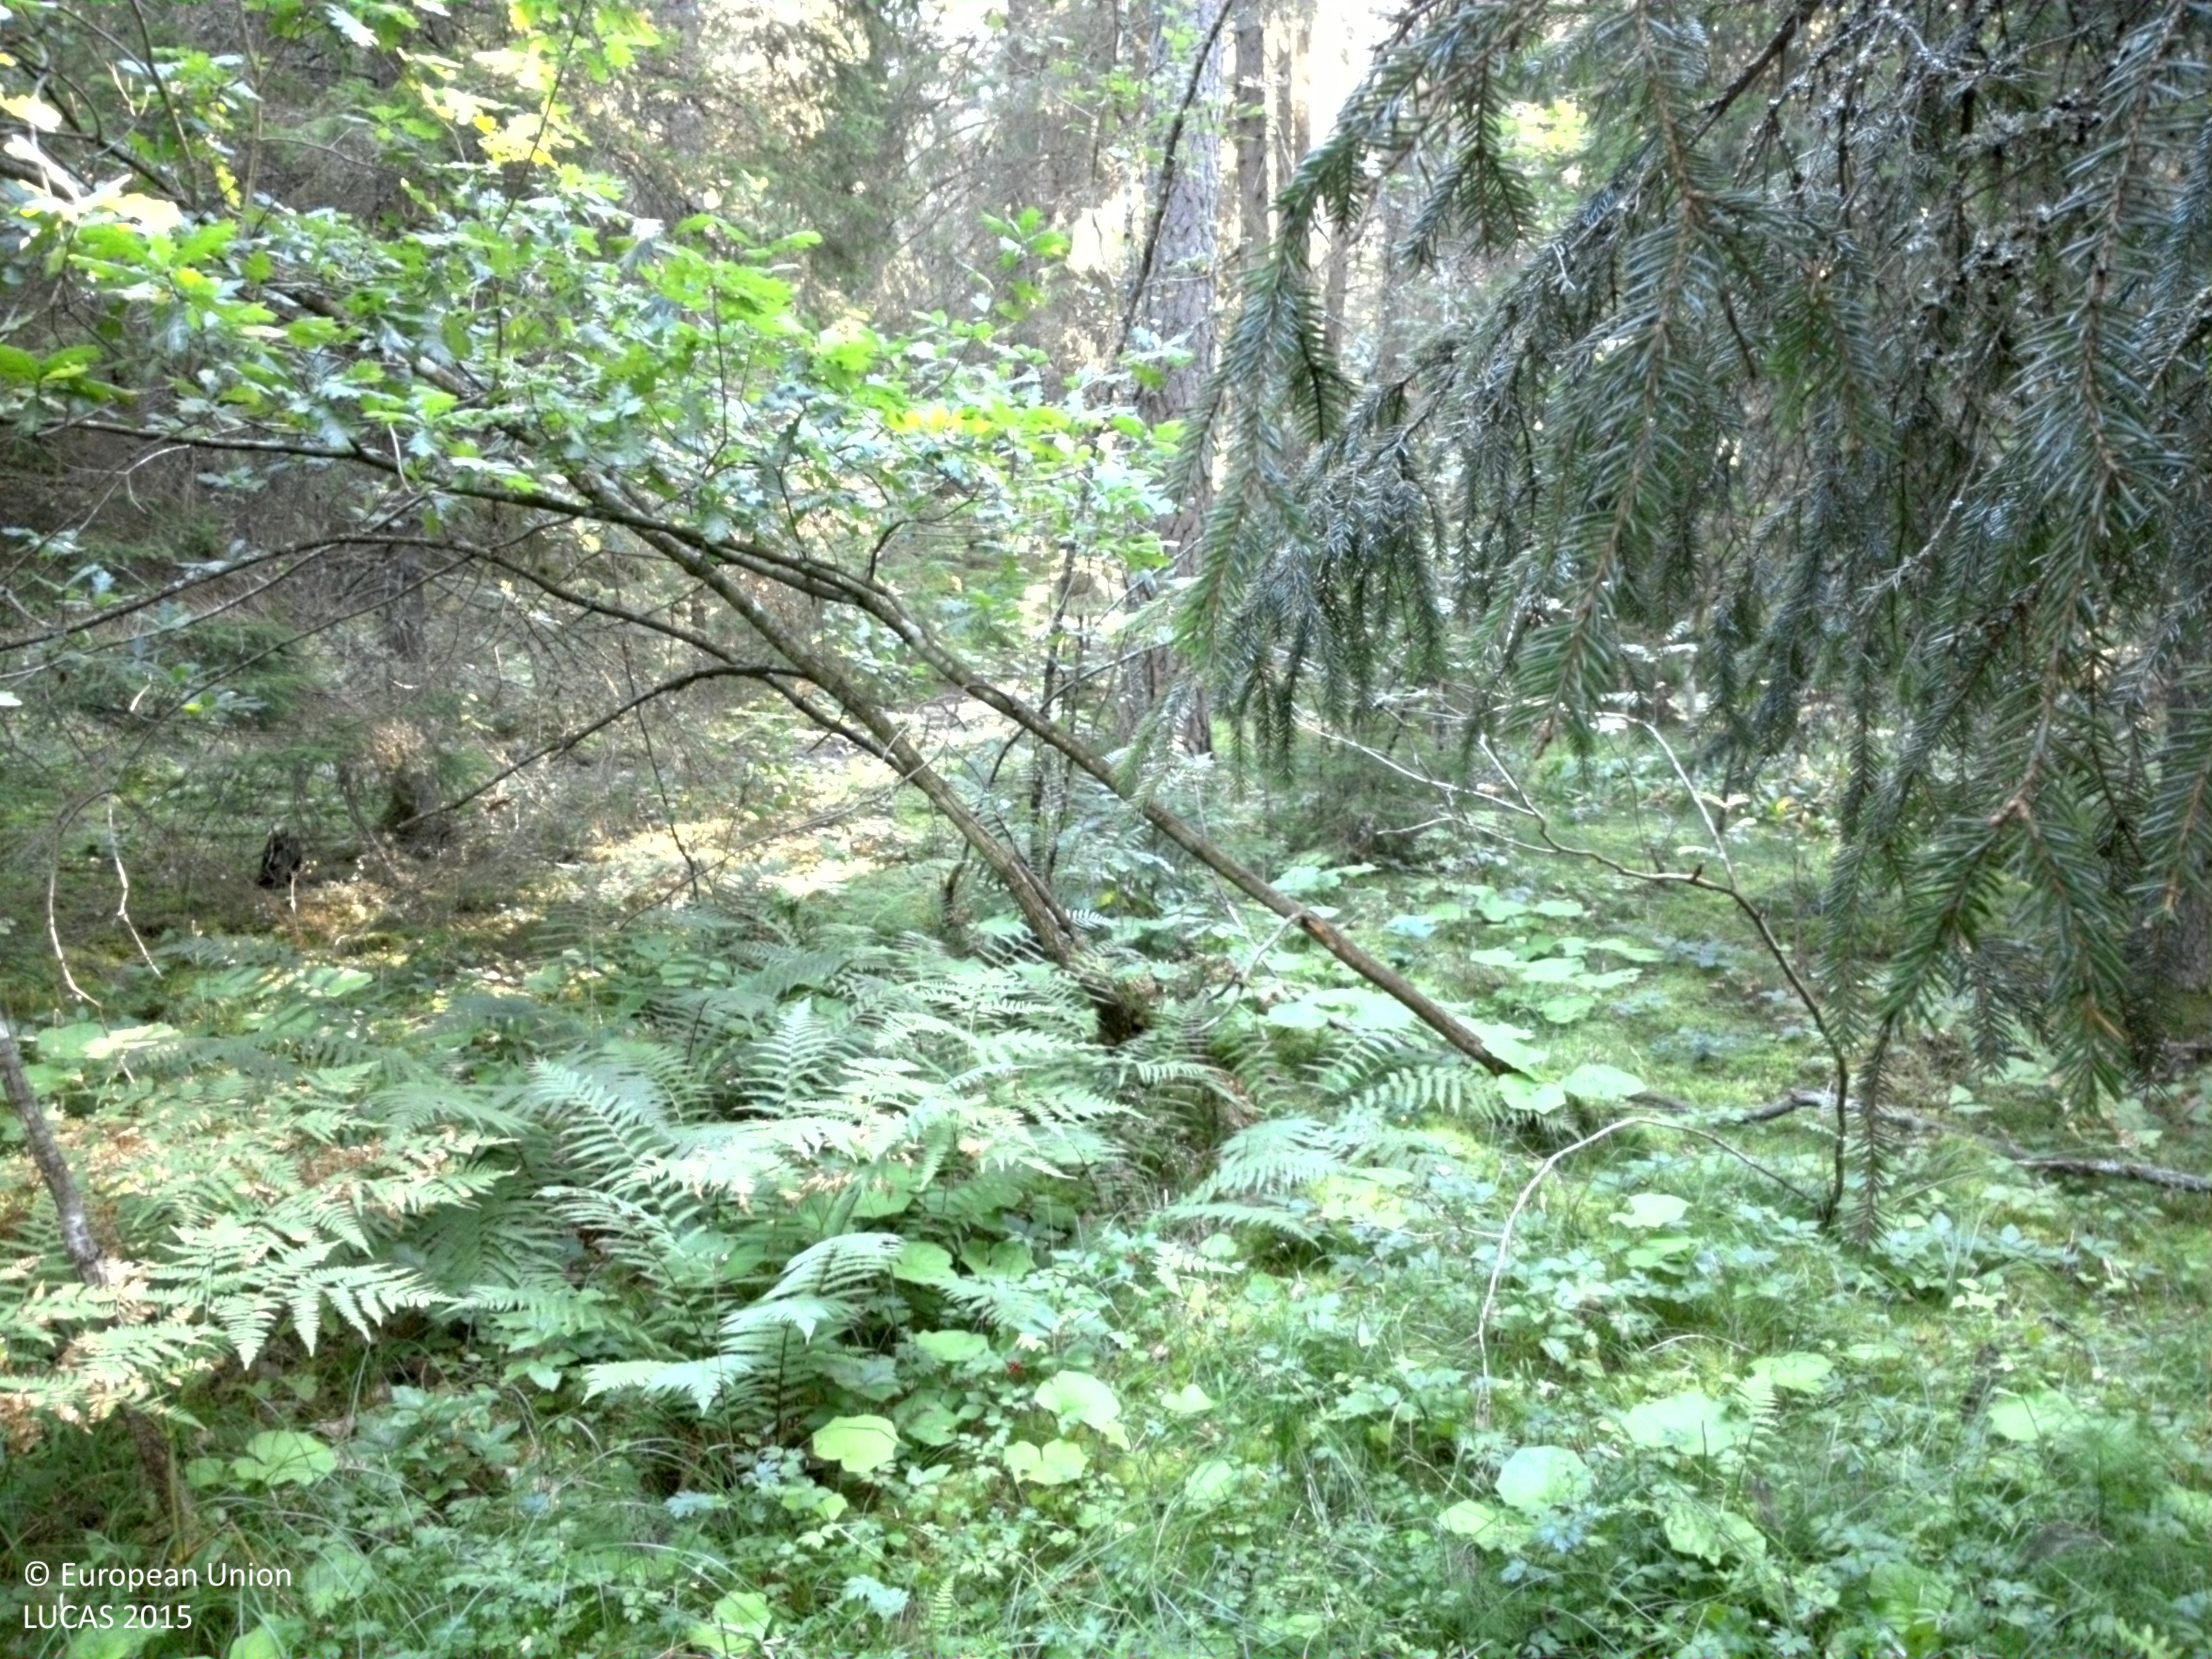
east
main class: Woodland
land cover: Spruce dominated coniferous woodland
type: boreal forest
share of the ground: > 75 %
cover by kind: coniferous forest trees 70 %, herbaceous plants 25 %, broadleaved forest trees 5 %
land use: Forestry
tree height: > 5 m
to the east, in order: Spruce dominated coniferous woodland; Tracks; Spruce dominated coniferous woodland; Pine dominated coniferous woodland; Broadleaved woodland; Ditches and canals; Other leguminous and mixtures for fodder
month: August
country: SE
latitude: 59.7311
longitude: 17.7680
